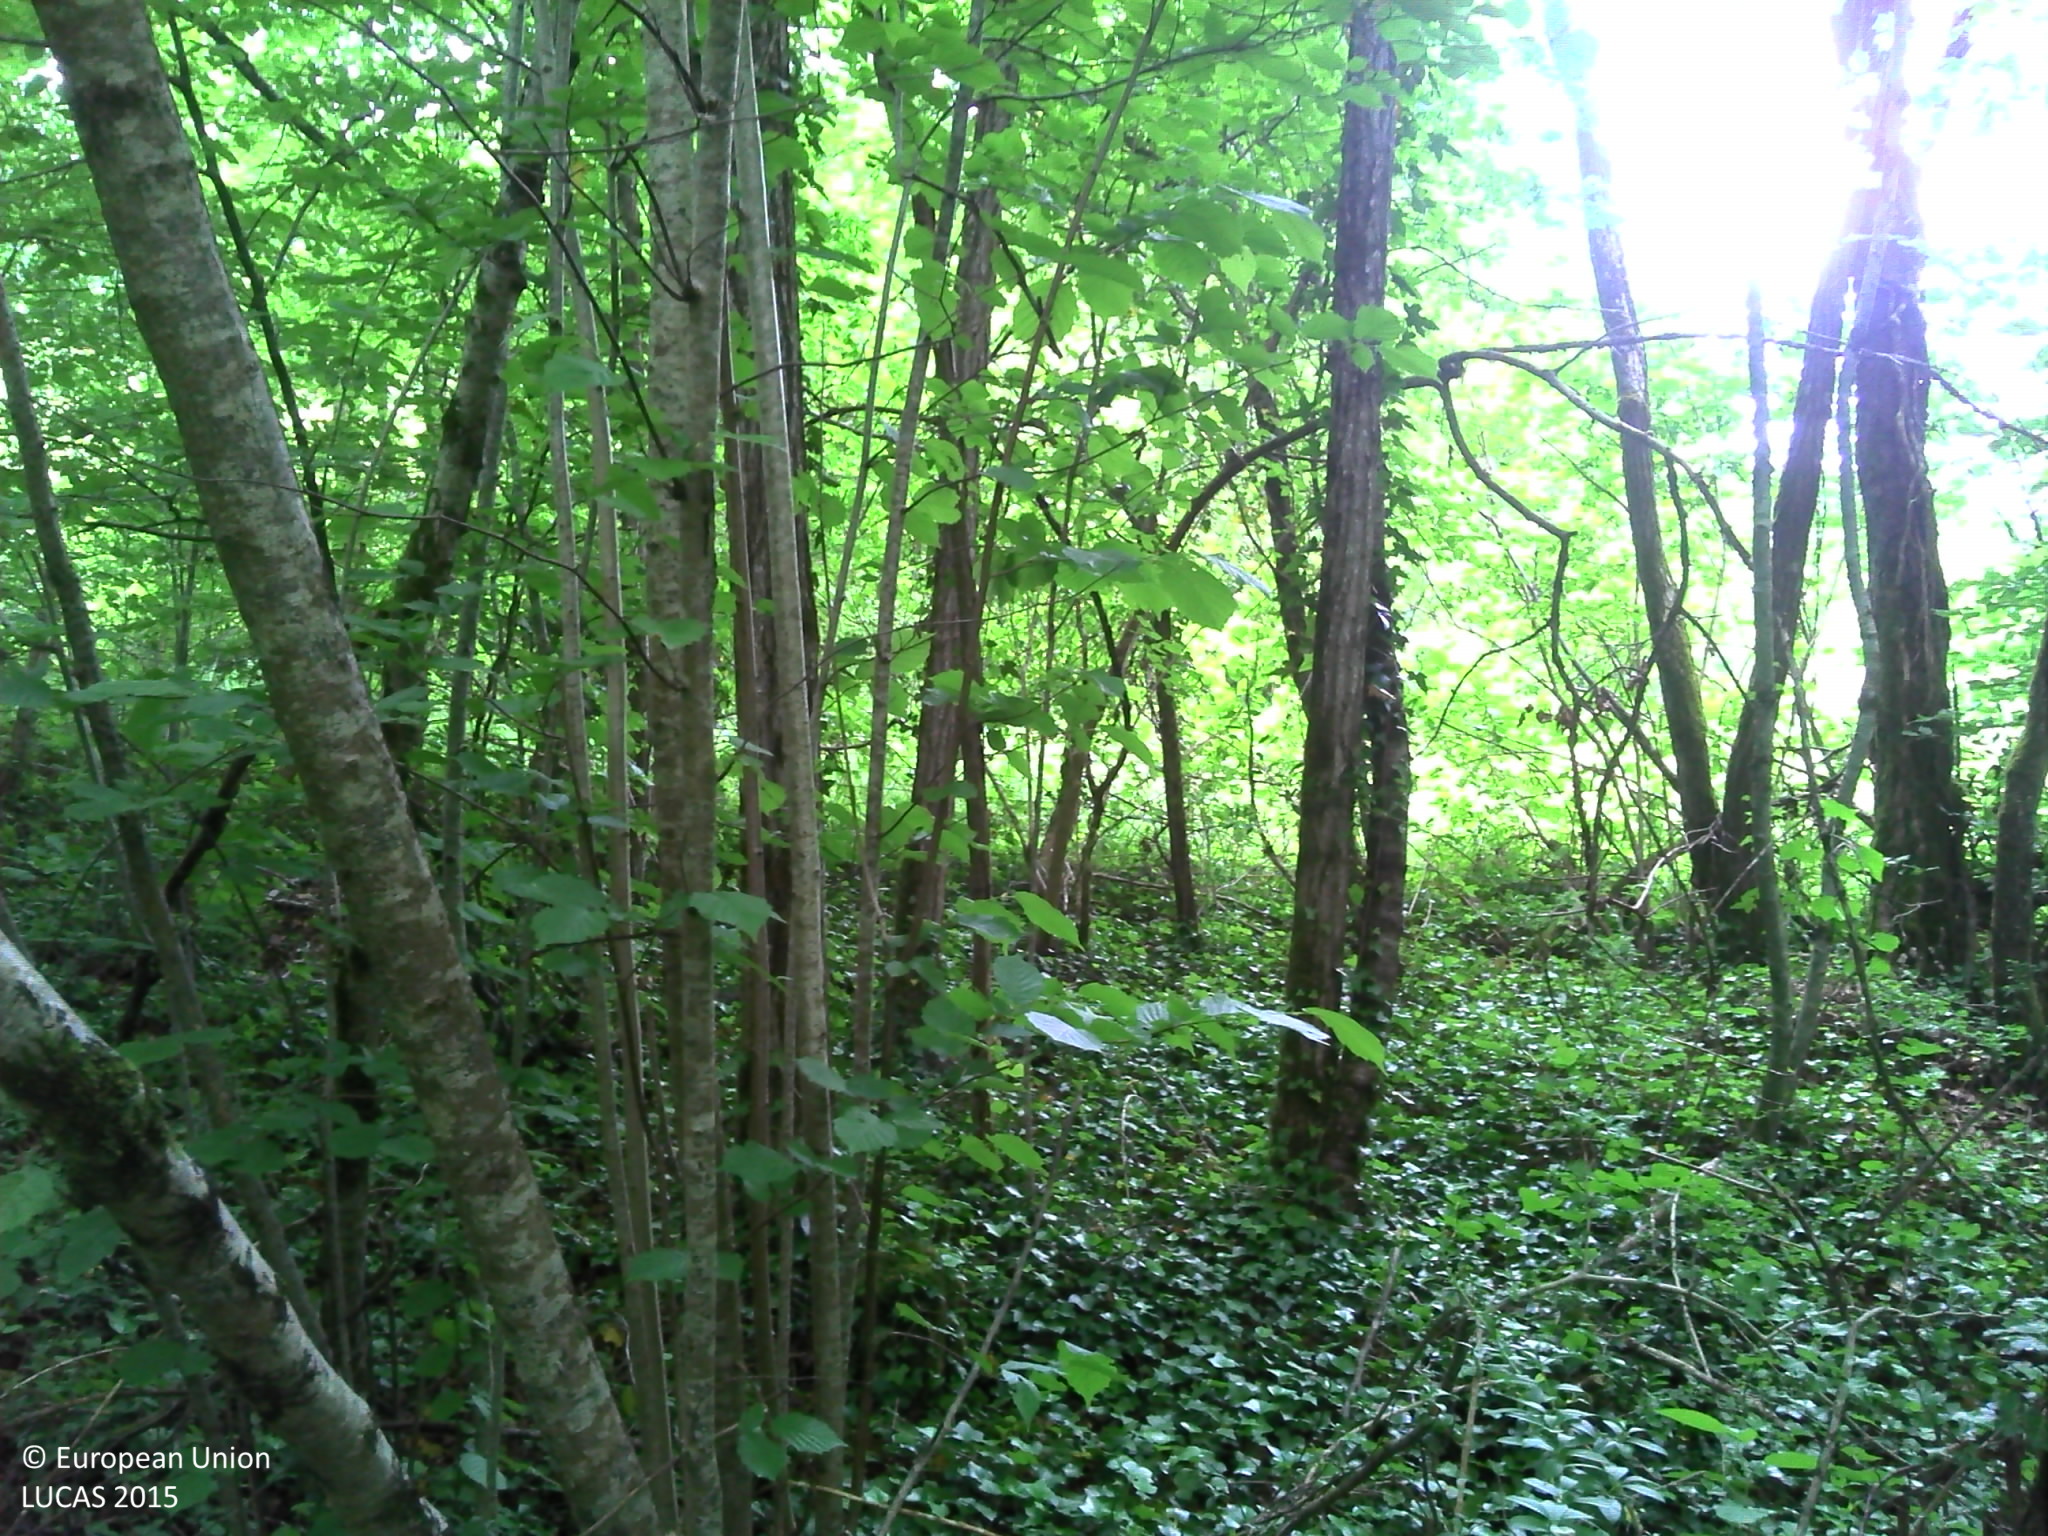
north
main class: Woodland
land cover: Broadleaved woodland
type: acidophilous oak and oak-birch forest
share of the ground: > 75 %
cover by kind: broadleaved forest trees 90 %, herbaceous plants 5 %, lichens and mosses 5 %
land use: Forestry
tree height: > 5 m
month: May
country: FR
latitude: 47.7860
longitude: 4.2718
